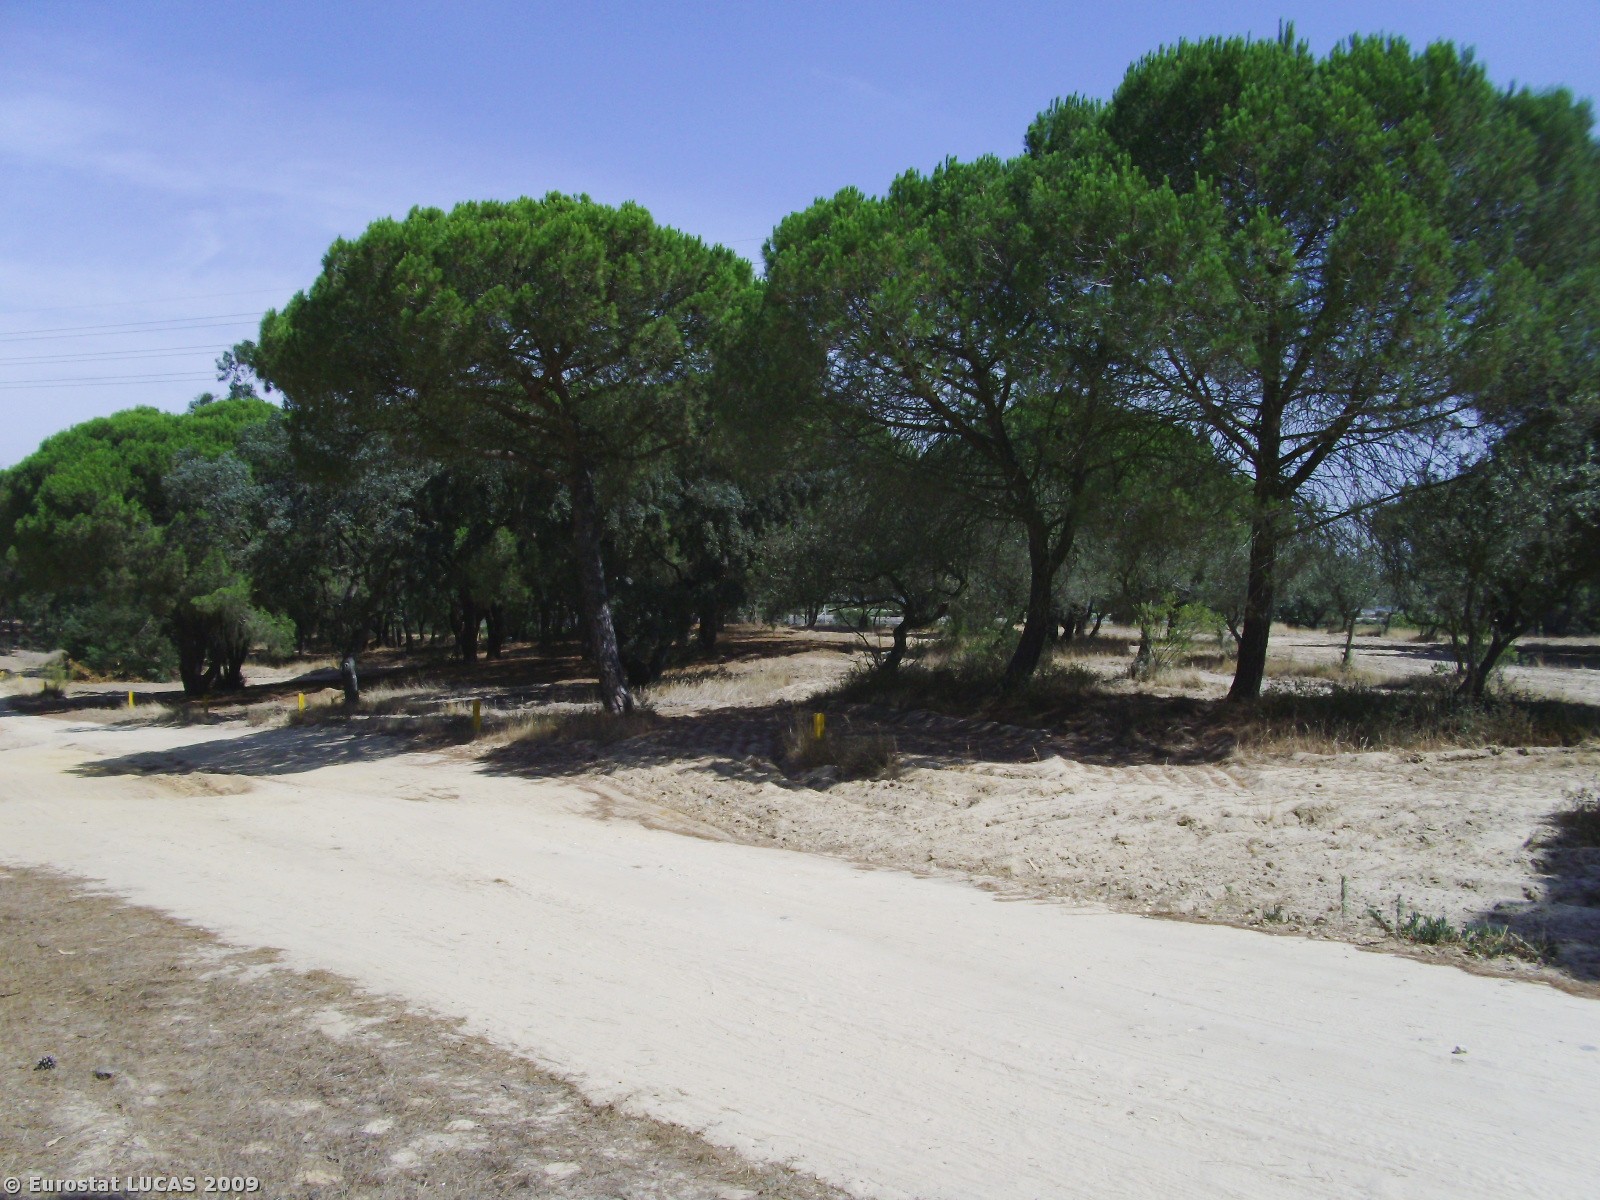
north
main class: Woodland
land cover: Broadleaved woodland
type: plantations and self-sown exotic forest
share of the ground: 25 - 50 %
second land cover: Bare land
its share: 50 - 75 %
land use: Forestry
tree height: > 5 m
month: July
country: PT
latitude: 38.5034
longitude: -8.8099
